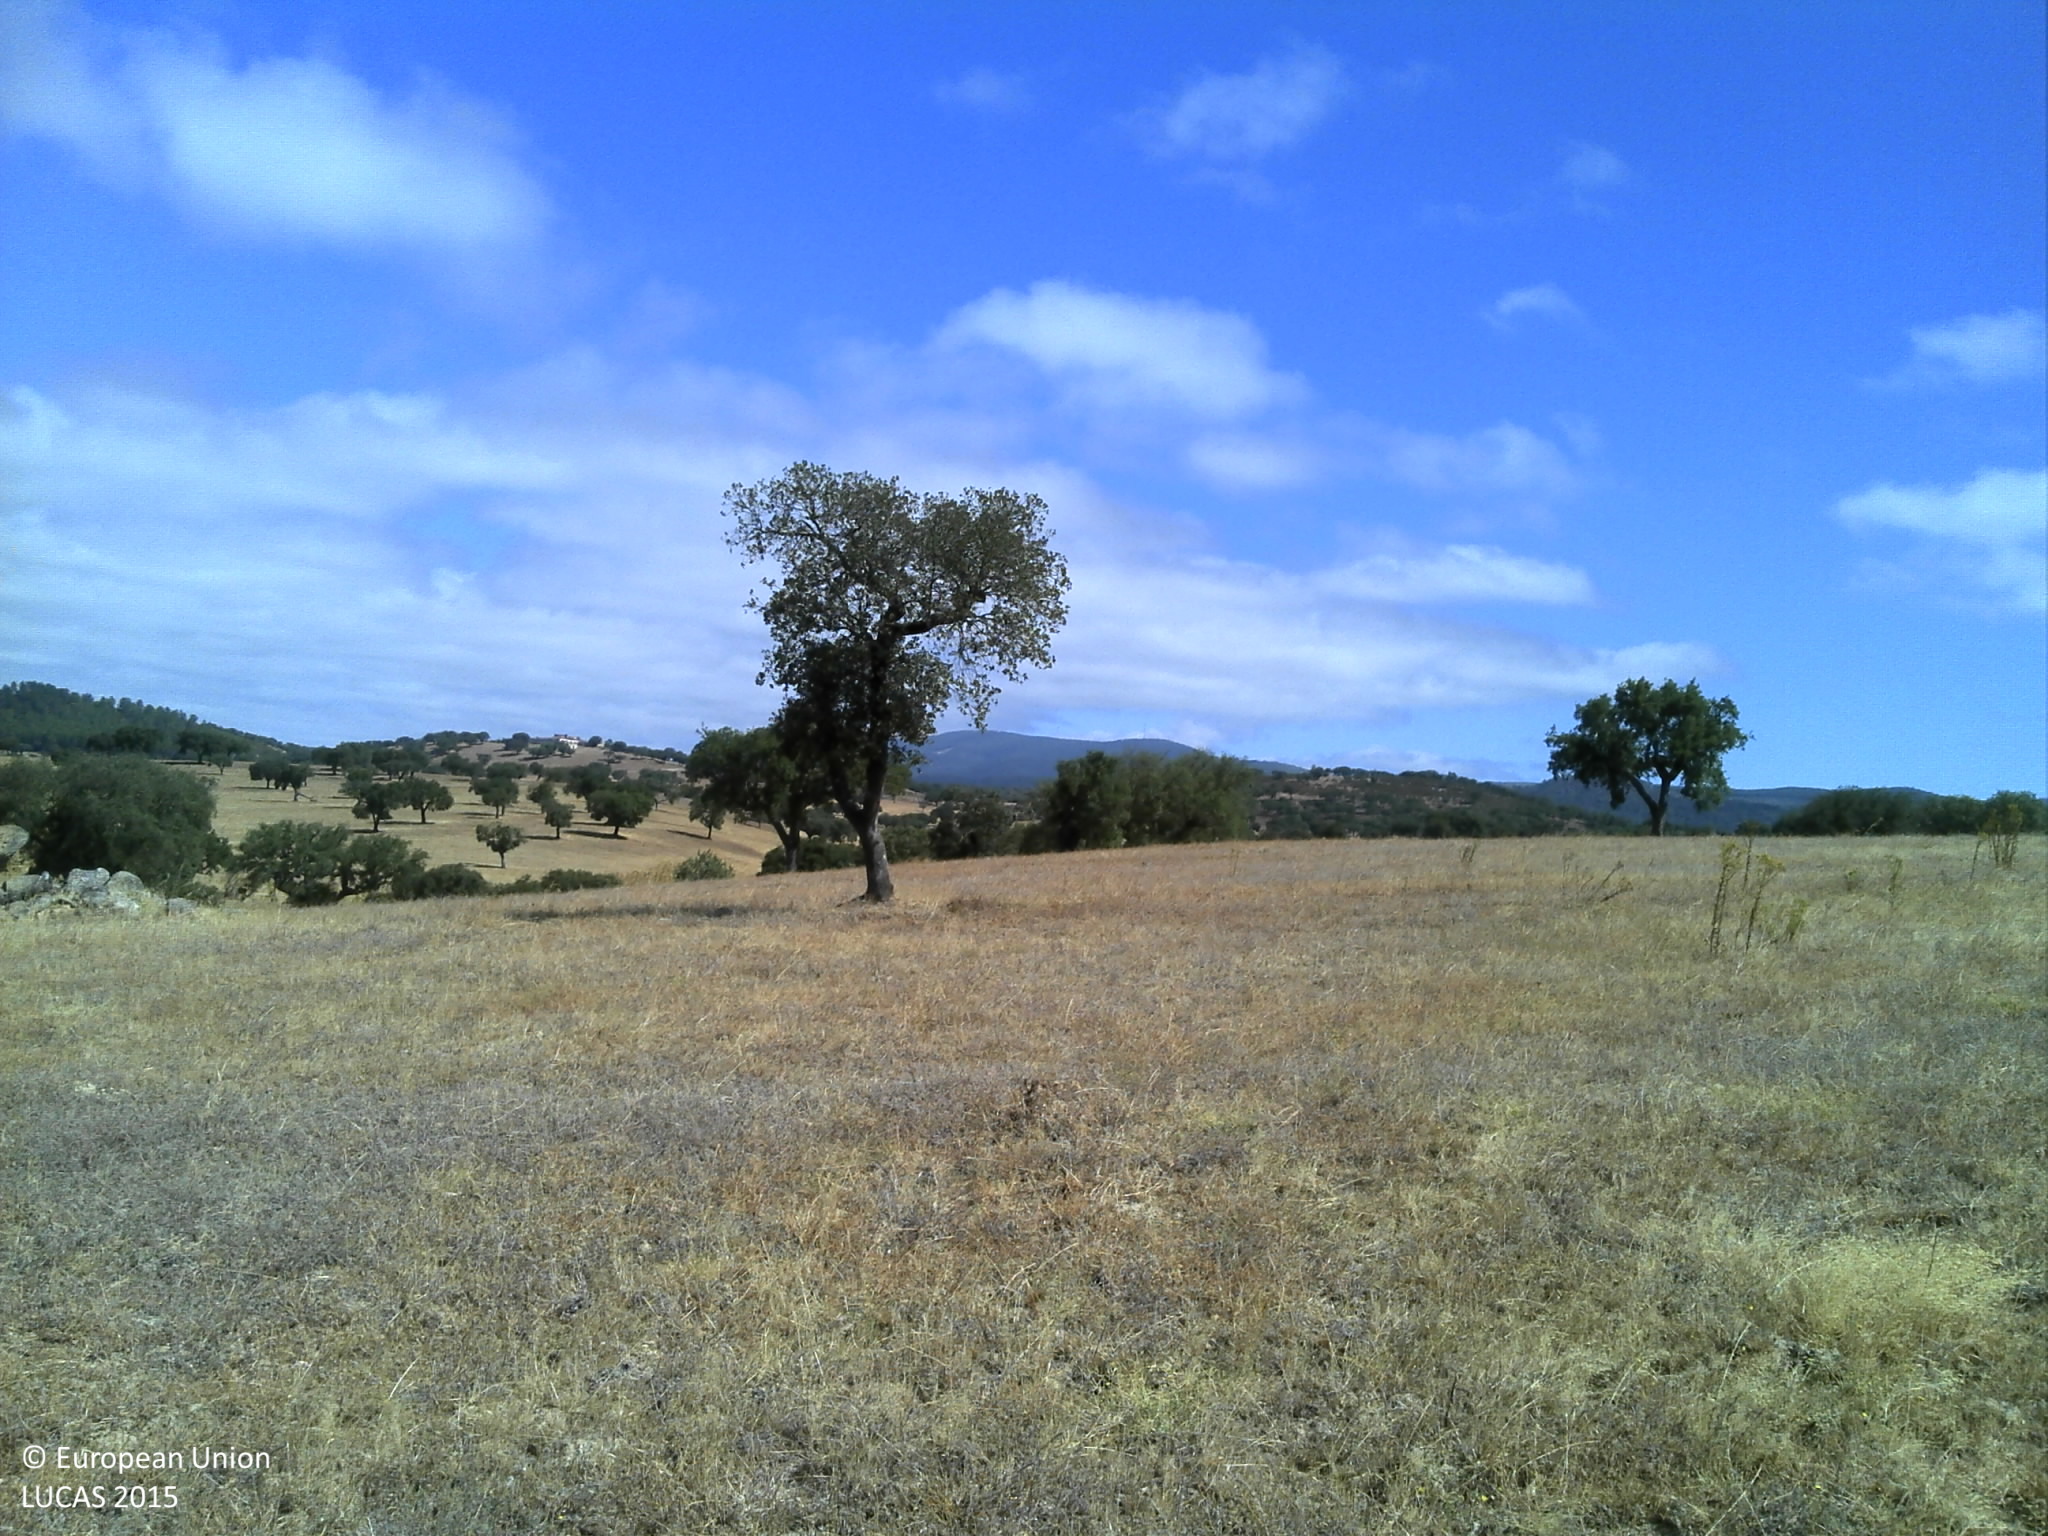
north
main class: Grassland
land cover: Spontaneously vegetated surfaces
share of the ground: 25 - 50 %
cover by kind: unconsolidated bare surface 70 %, herbaceous plants 30 %
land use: Agriculture (excluding fallow land and kitchen gardens)
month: July
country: PT
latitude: 39.2063
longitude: -7.3507
